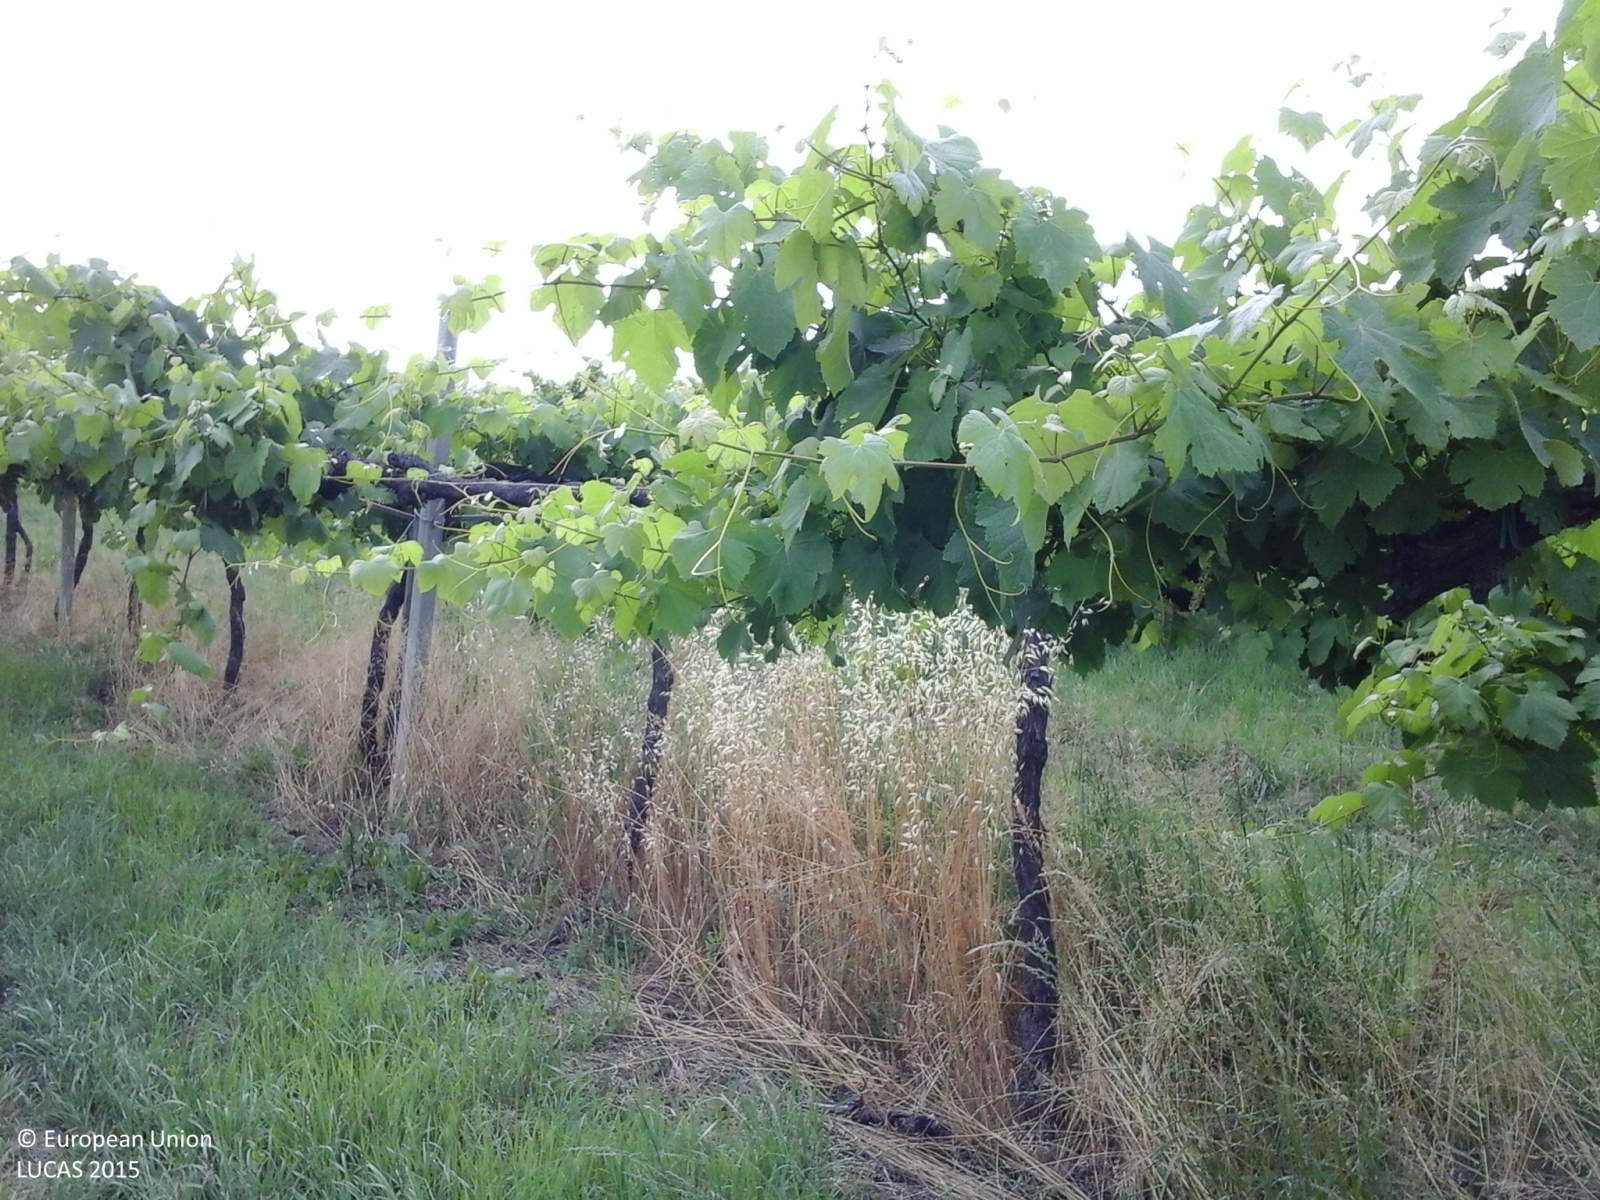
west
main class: Cropland
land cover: Vineyards
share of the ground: 25 - 50 %
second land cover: Grassland without tree/shrub cover
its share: 50 - 75 %
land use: Agriculture (excluding fallow land and kitchen gardens)
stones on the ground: < 10 %
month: May
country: IT
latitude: 44.7630
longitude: 10.6934
